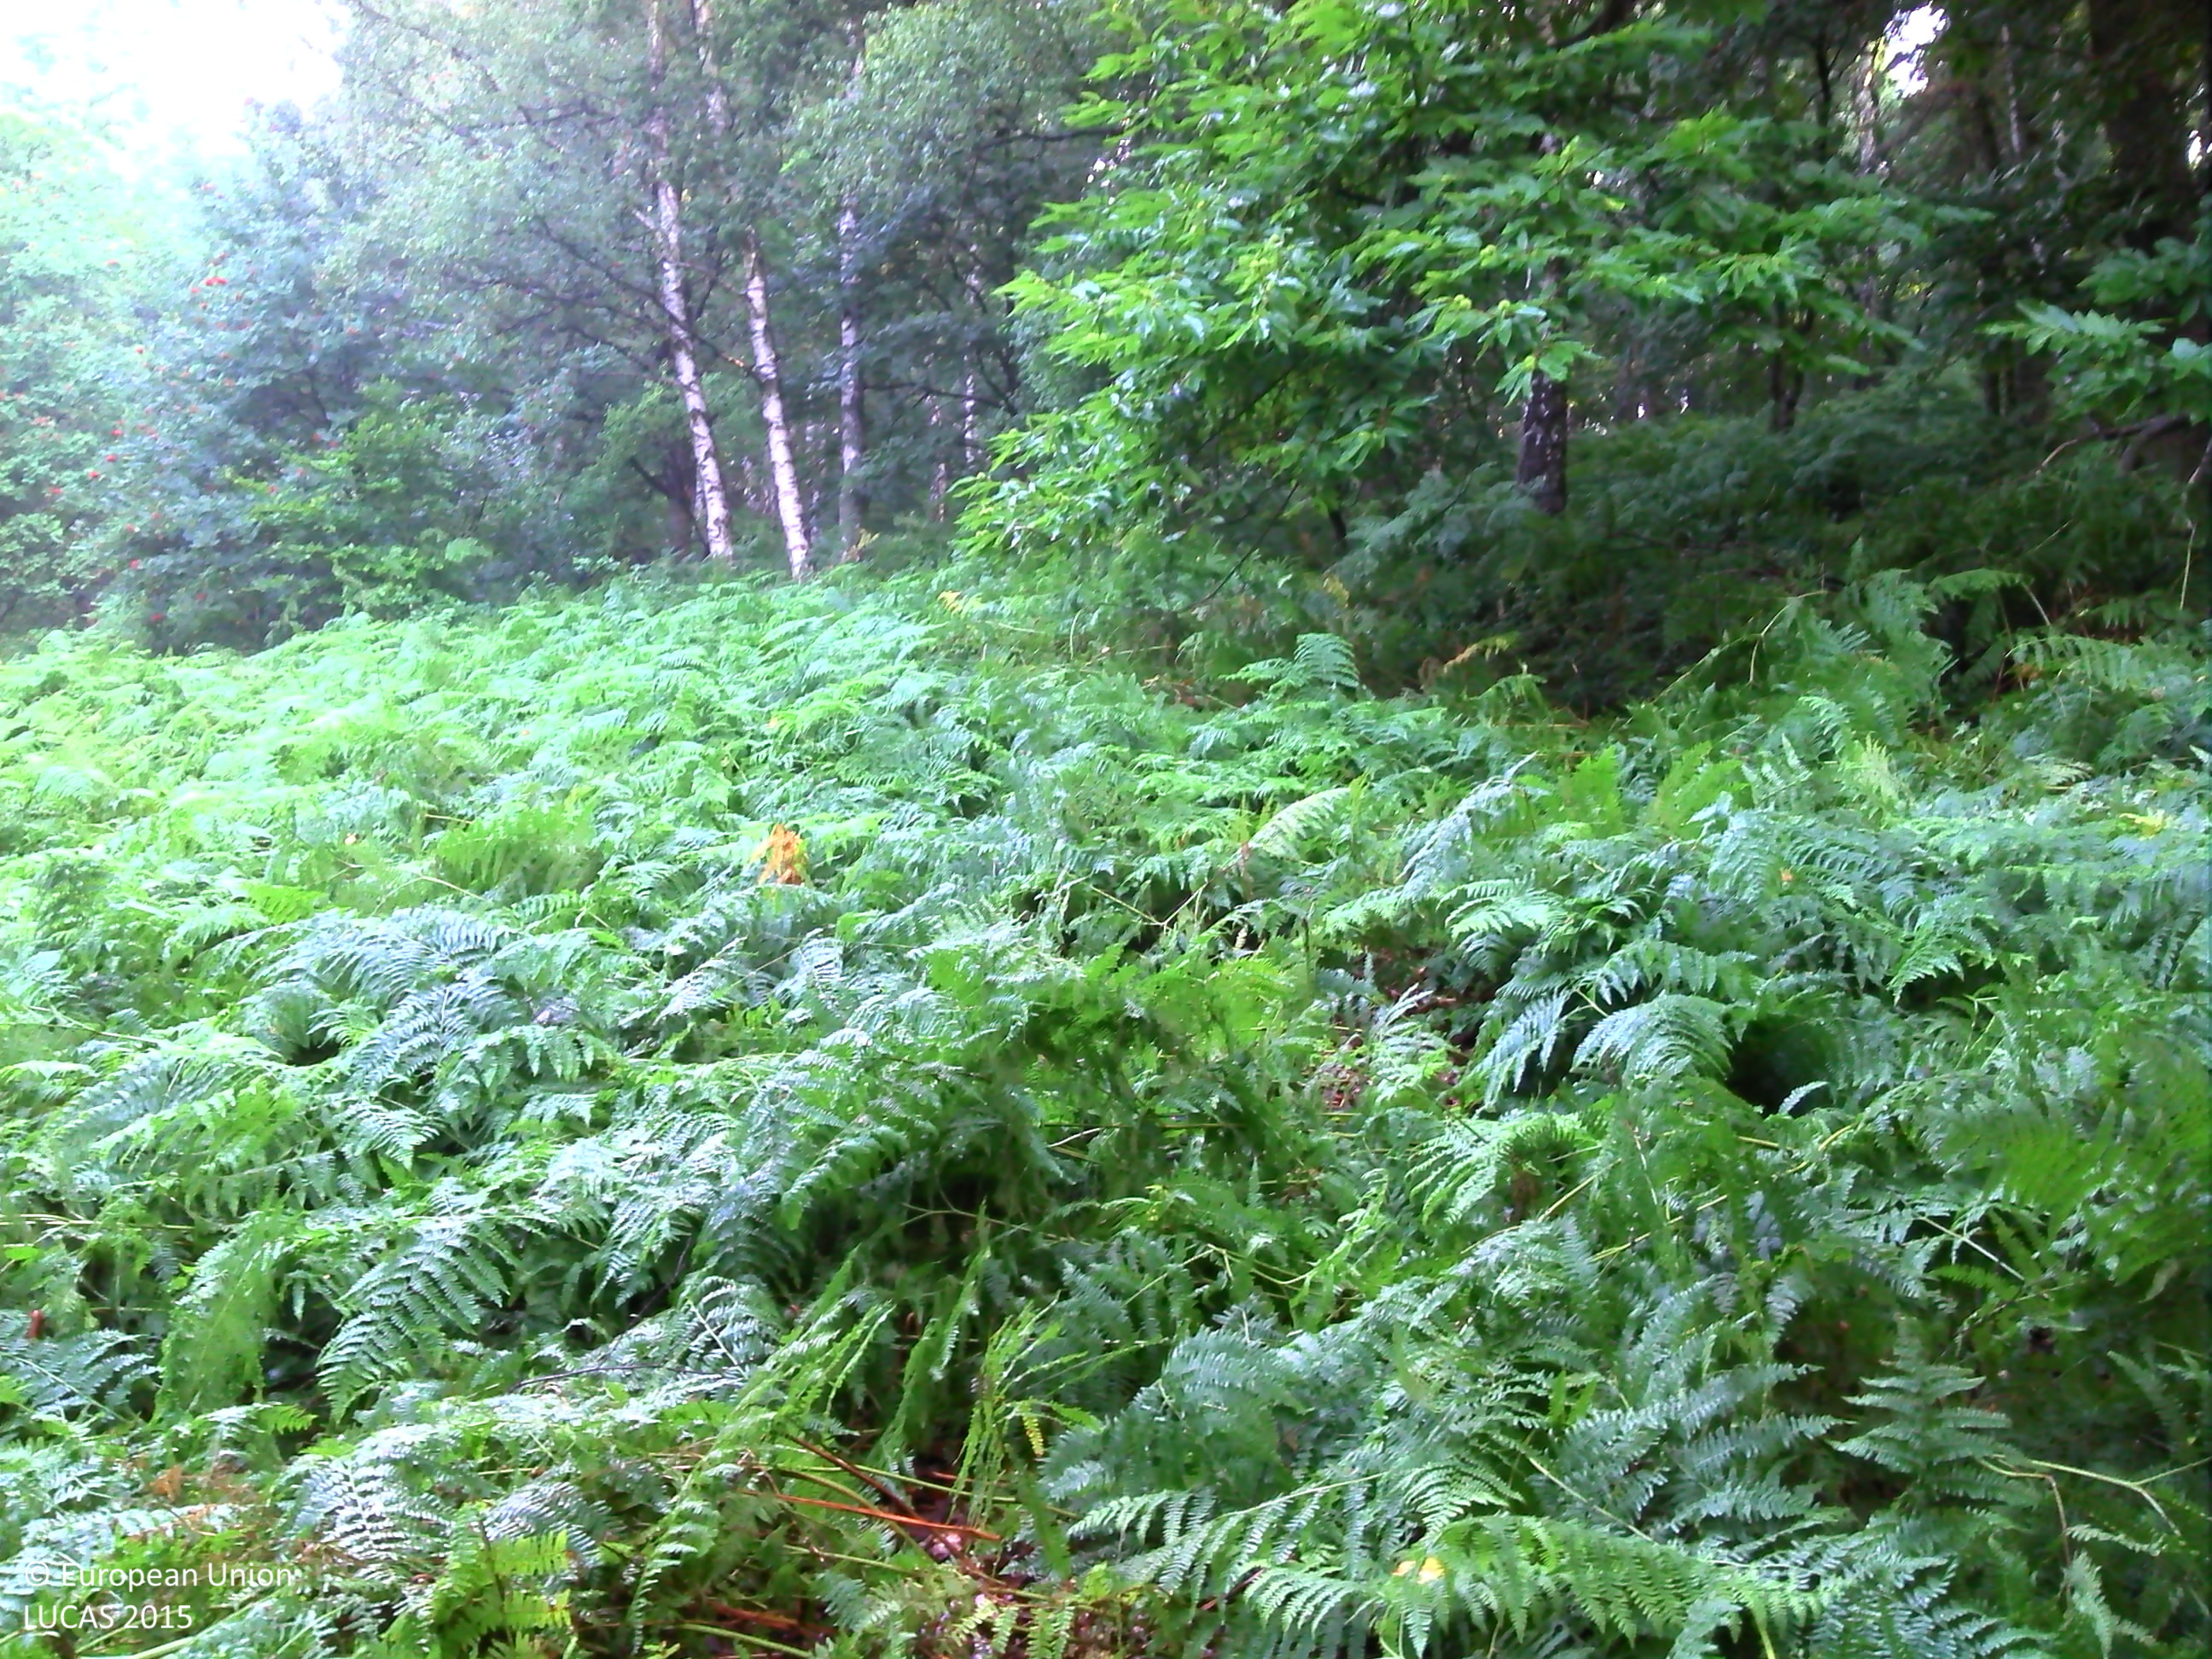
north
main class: Woodland
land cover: Broadleaved woodland
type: mesophytic deciduous forest
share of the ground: > 75 %
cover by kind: broadleaved forest trees 70 %, herbaceous plants 30 %
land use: Forestry
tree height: > 5 m
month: August
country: BE
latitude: 50.6639
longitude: 5.7685
